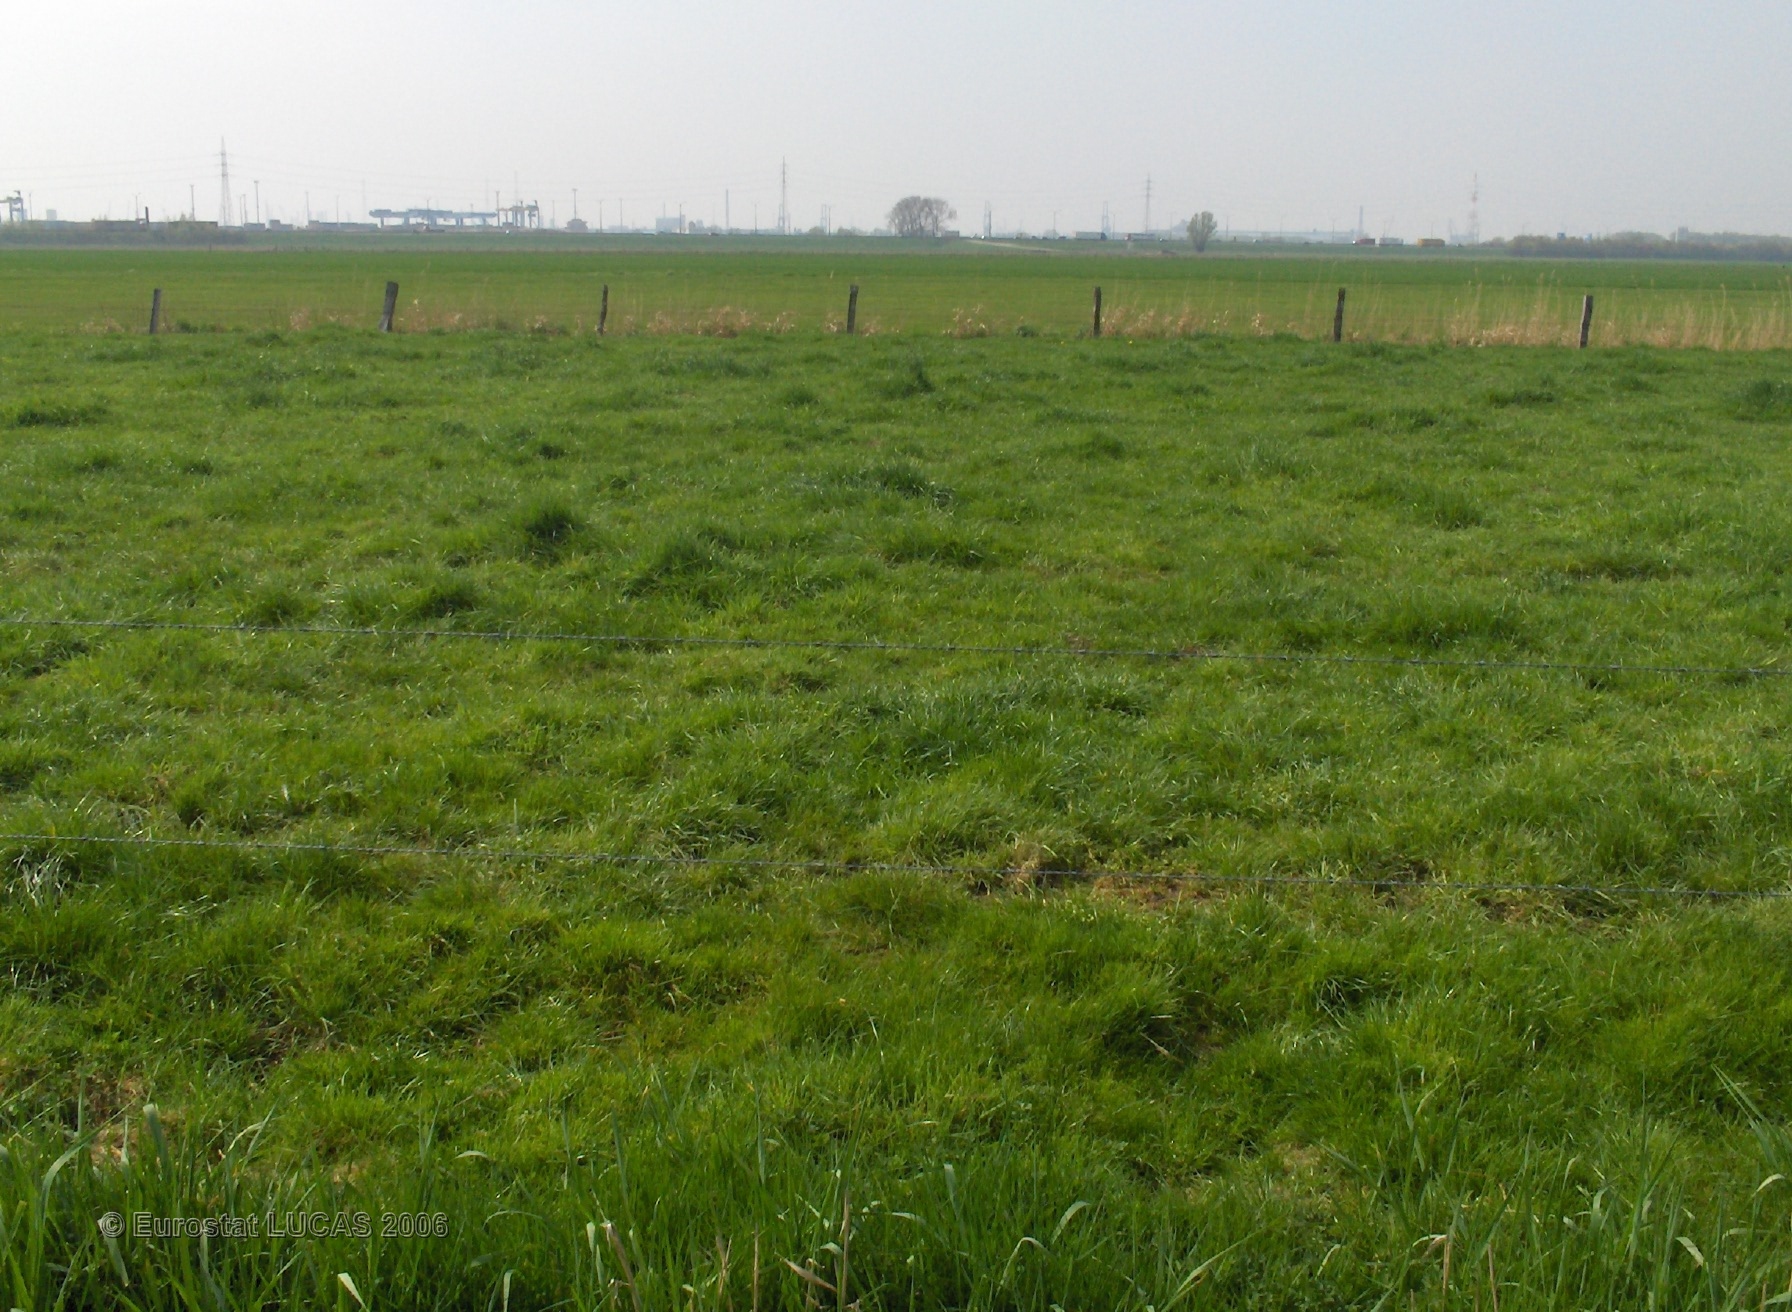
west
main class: Grassland
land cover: Grassland without tree/shrub cover
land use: Agriculture (excluding fallow land and kitchen gardens)
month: April
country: BE
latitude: 51.3077
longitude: 4.3865
